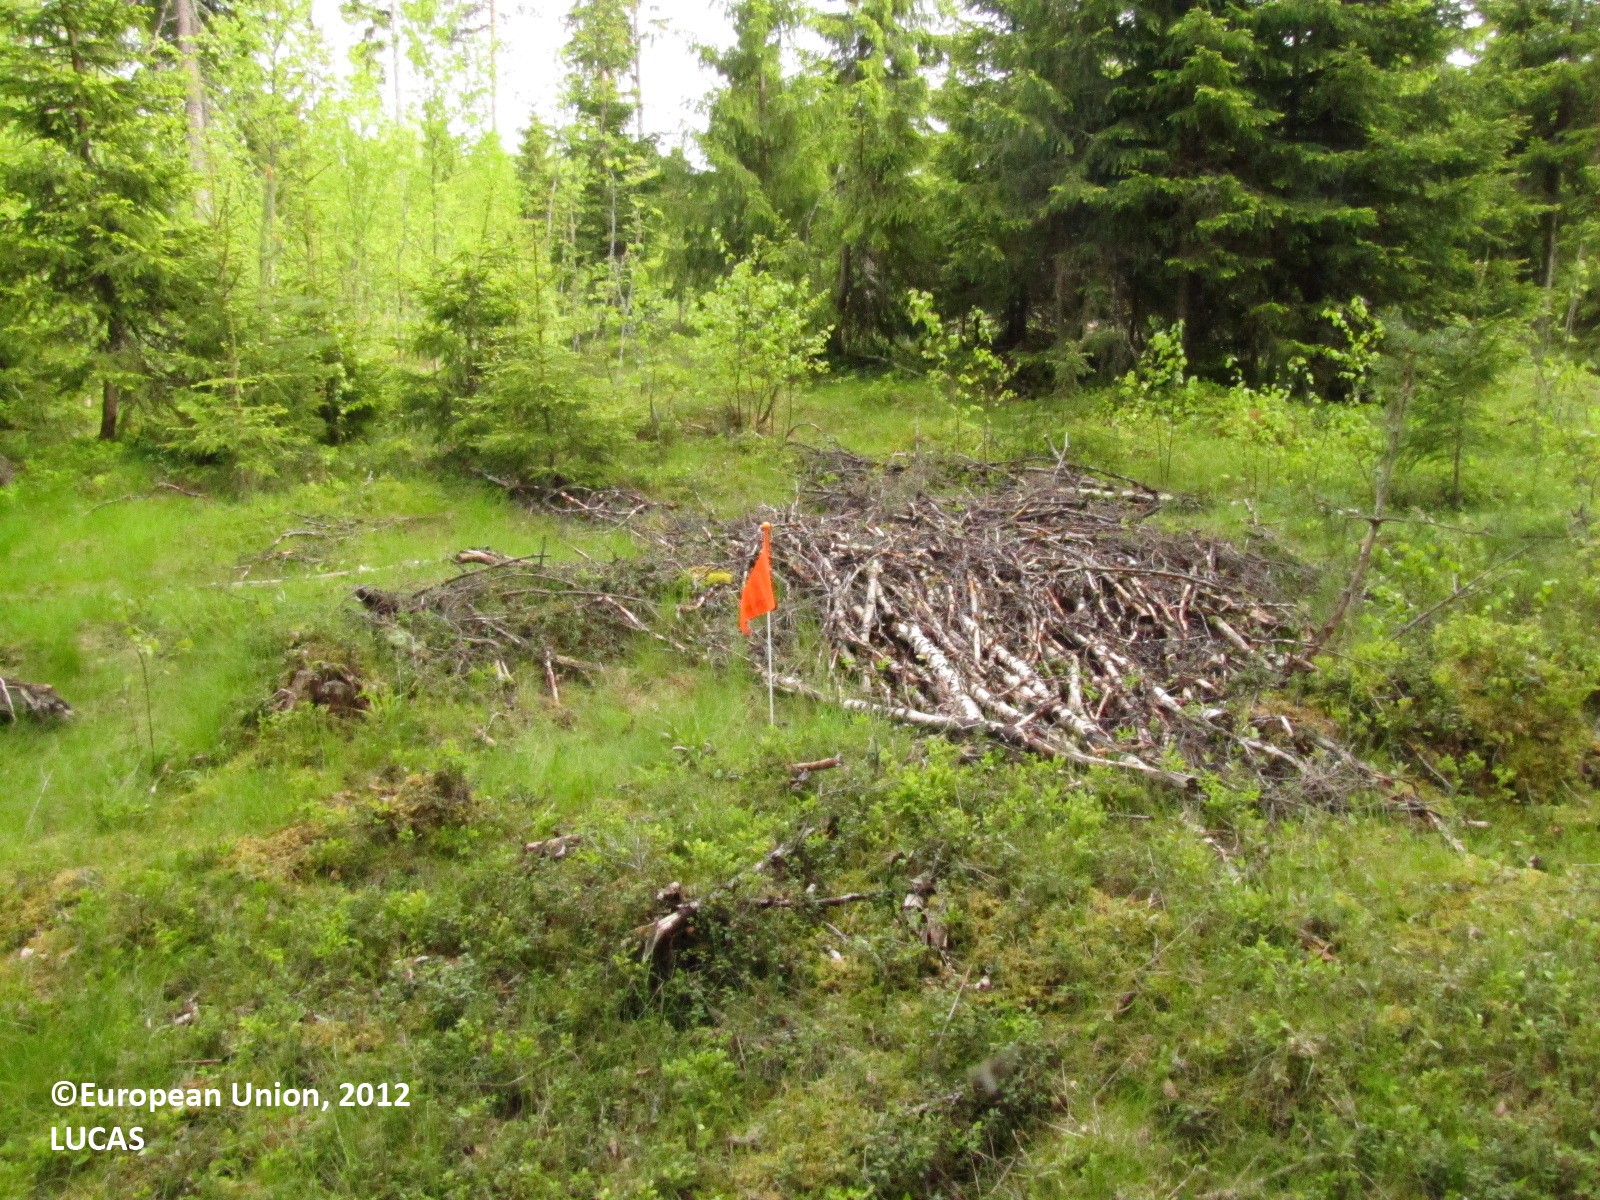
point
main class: Woodland
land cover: Spruce dominated mixed woodland
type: boreal forest
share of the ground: > 75 %
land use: Forestry
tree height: < 5 m
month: June
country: FI
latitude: 61.6398
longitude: 23.0352
